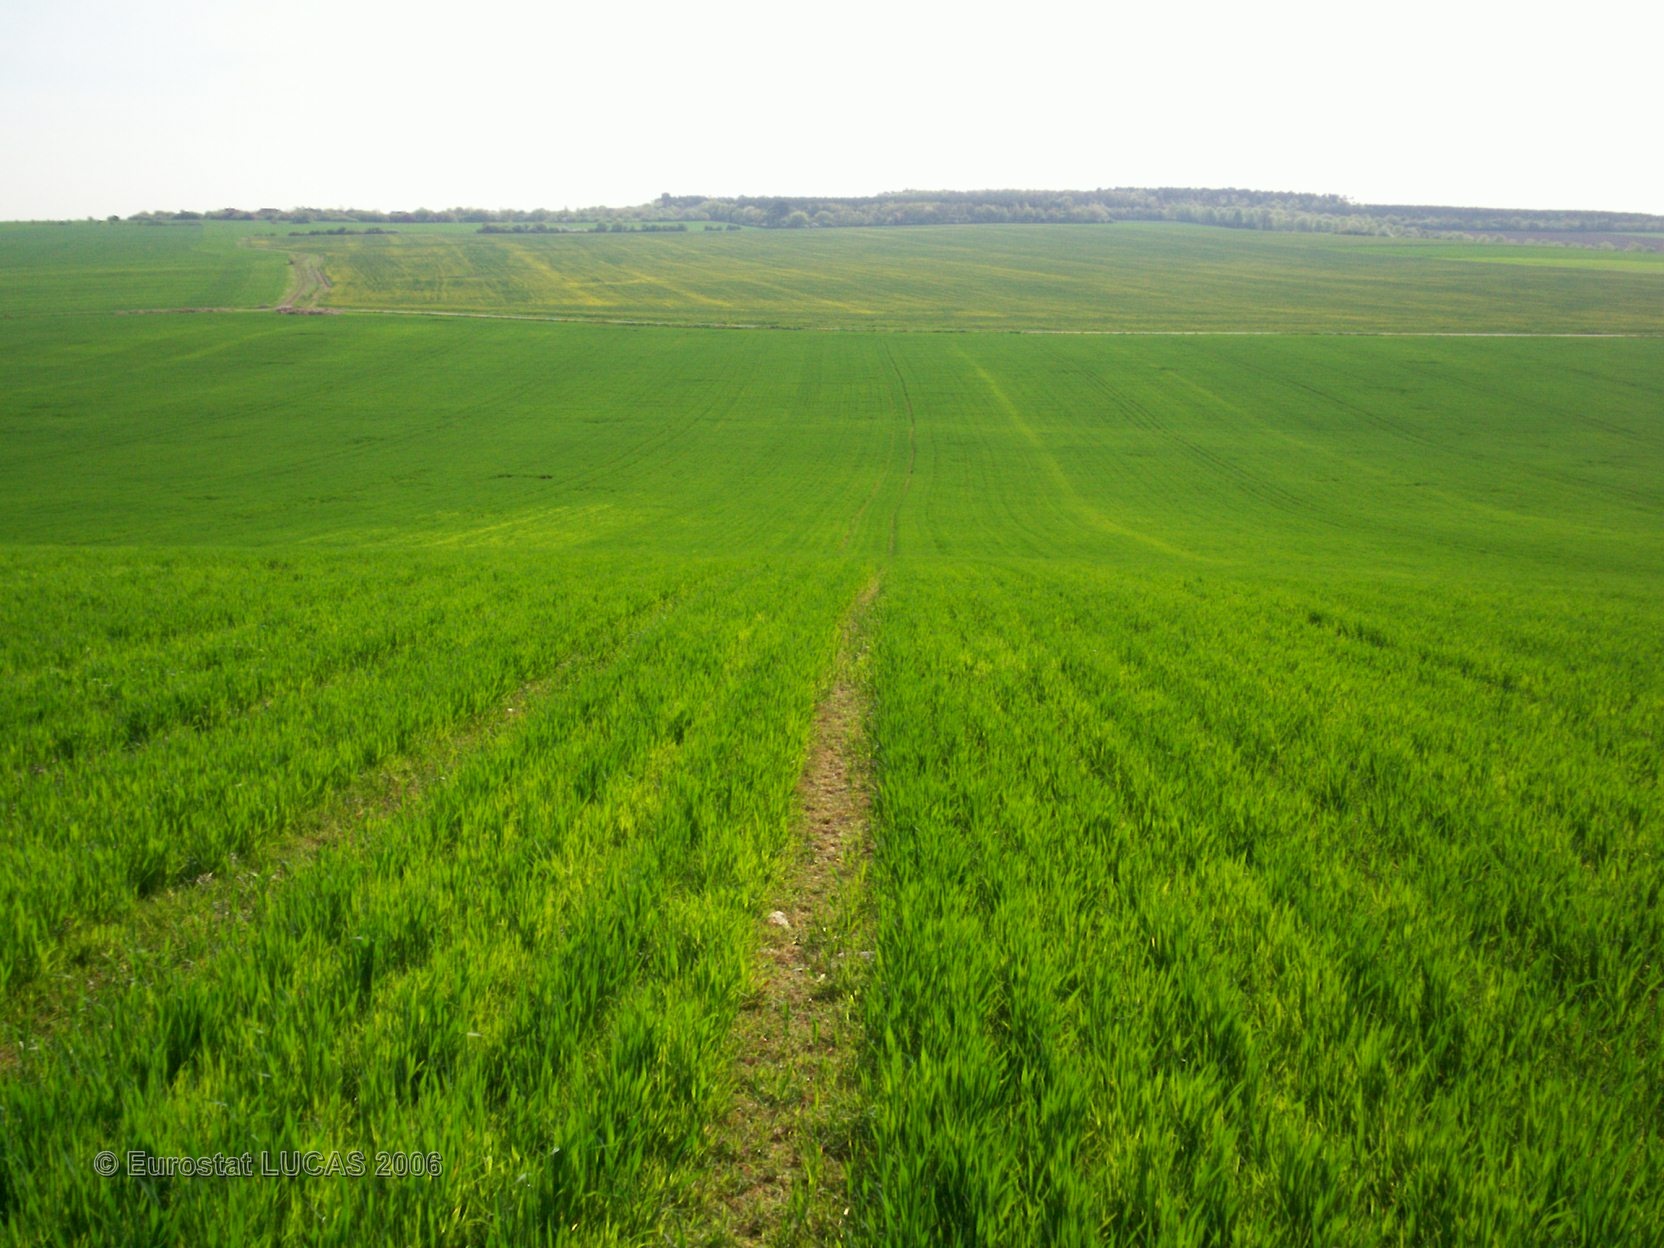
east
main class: Cropland
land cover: Common wheat
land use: Agriculture (excluding fallow land and kitchen gardens)
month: May
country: FR
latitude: 49.1774
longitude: 6.5294
